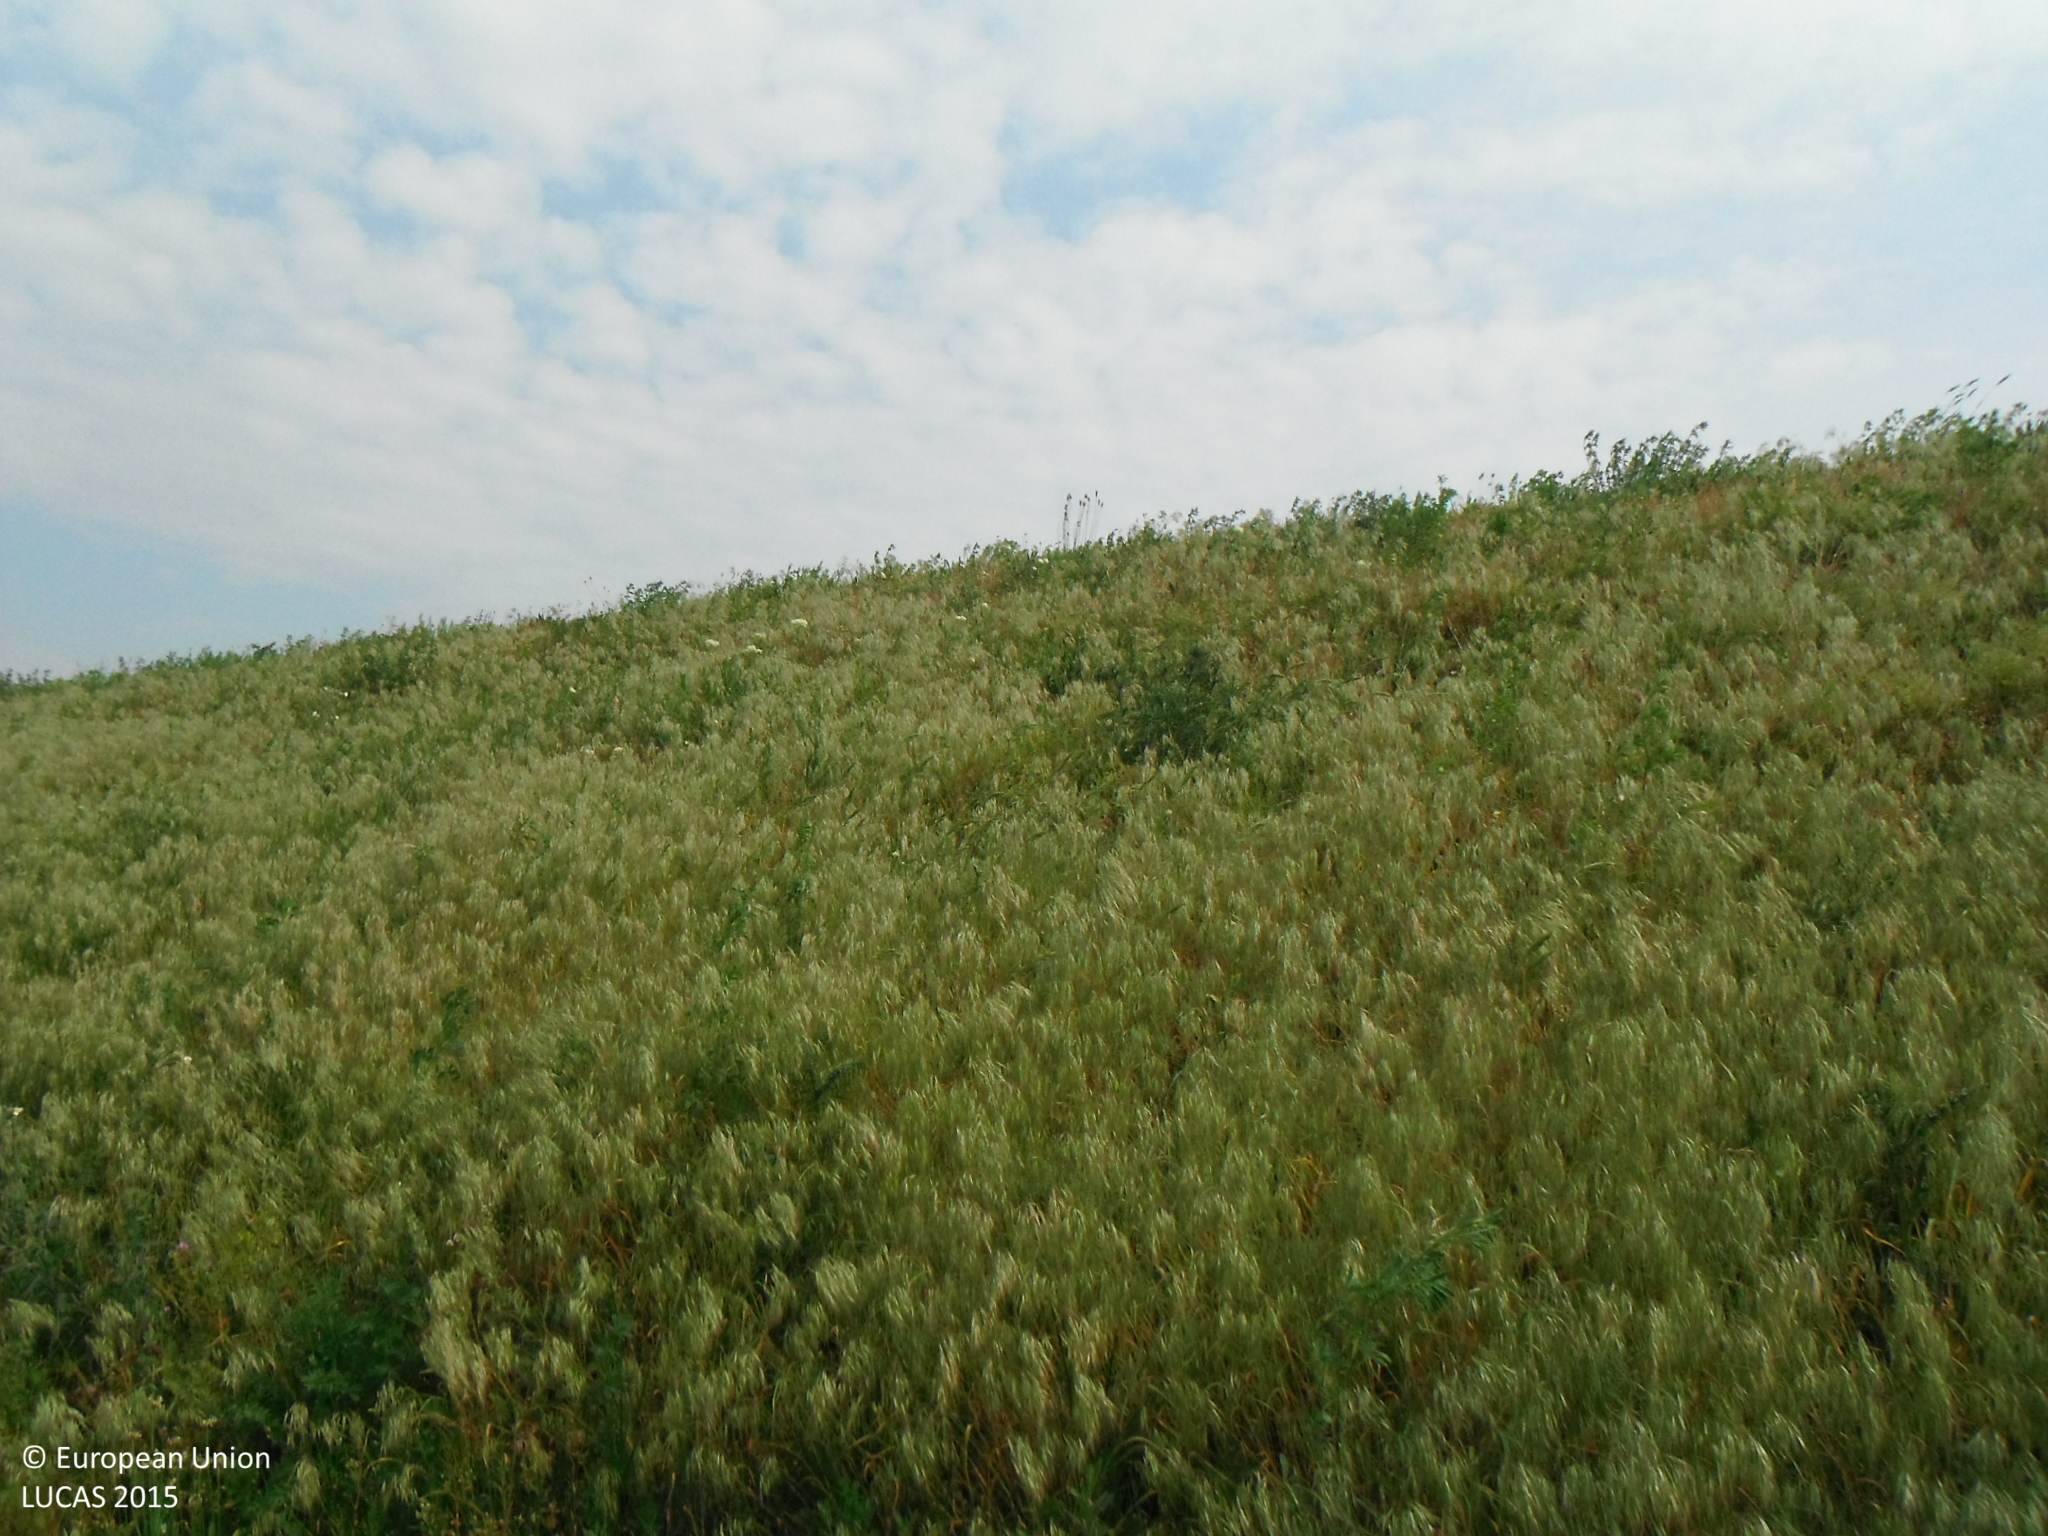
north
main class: Grassland
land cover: Grassland without tree/shrub cover
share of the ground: > 75 %
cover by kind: herbaceous plants 100 %
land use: Protection infrastructures
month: May
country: SK
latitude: 47.9753
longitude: 17.3902
